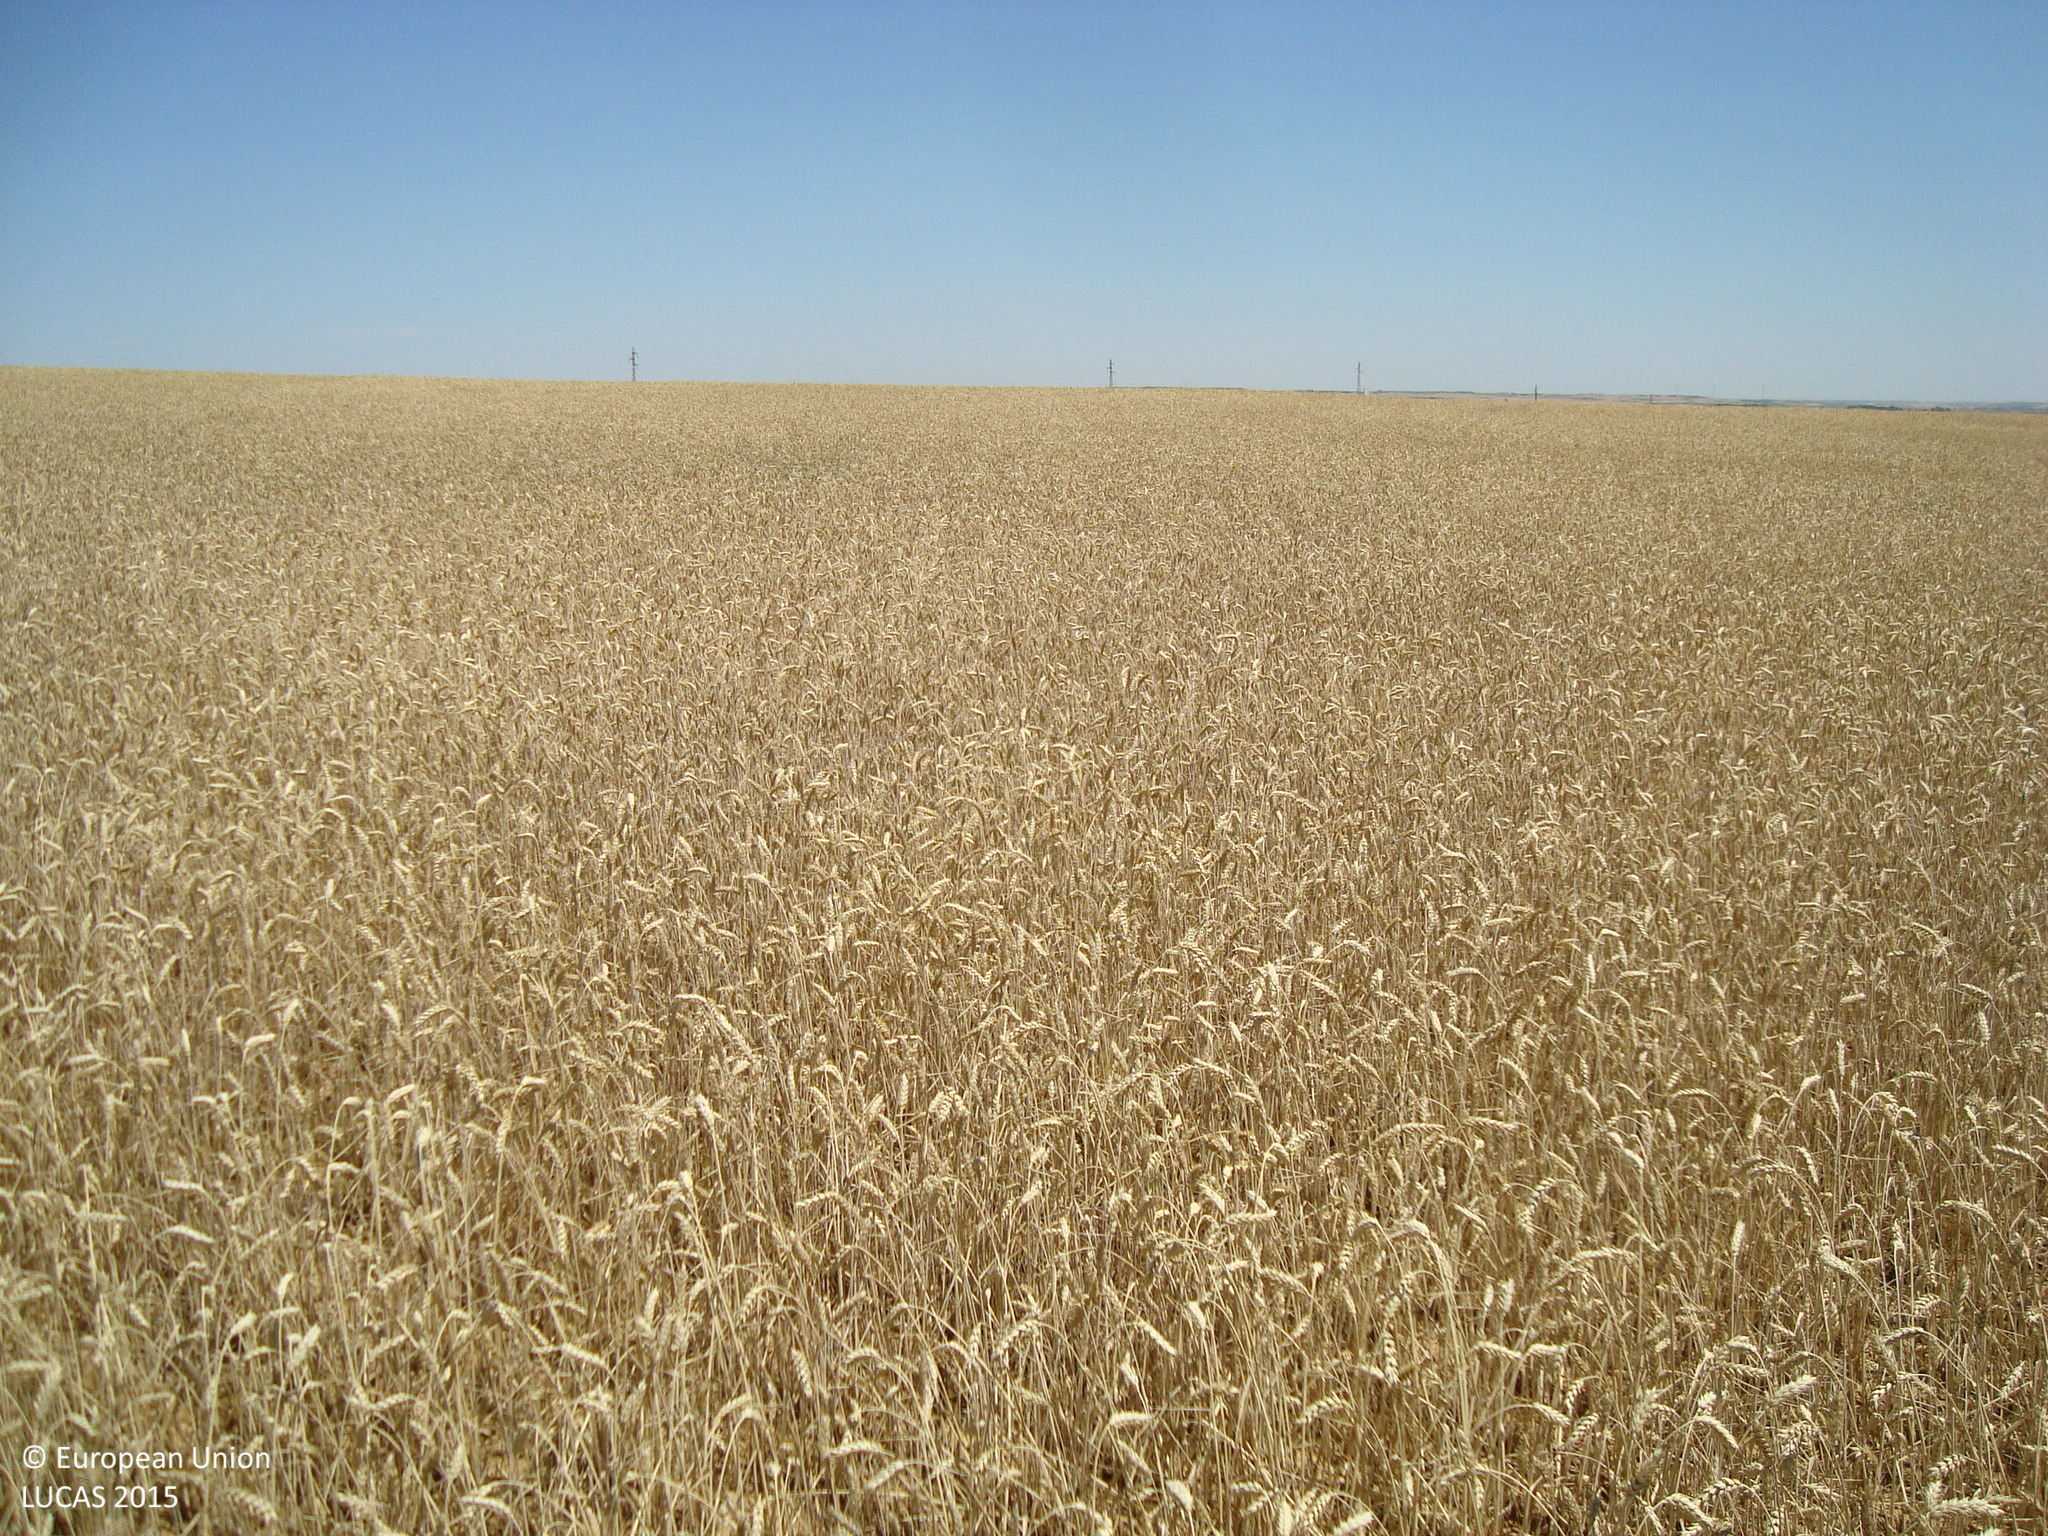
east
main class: Cropland
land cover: Common wheat
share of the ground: > 75 %
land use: Agriculture (excluding fallow land and kitchen gardens)
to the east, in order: Common wheat
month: July
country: ES
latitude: 42.1495
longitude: -4.7791
